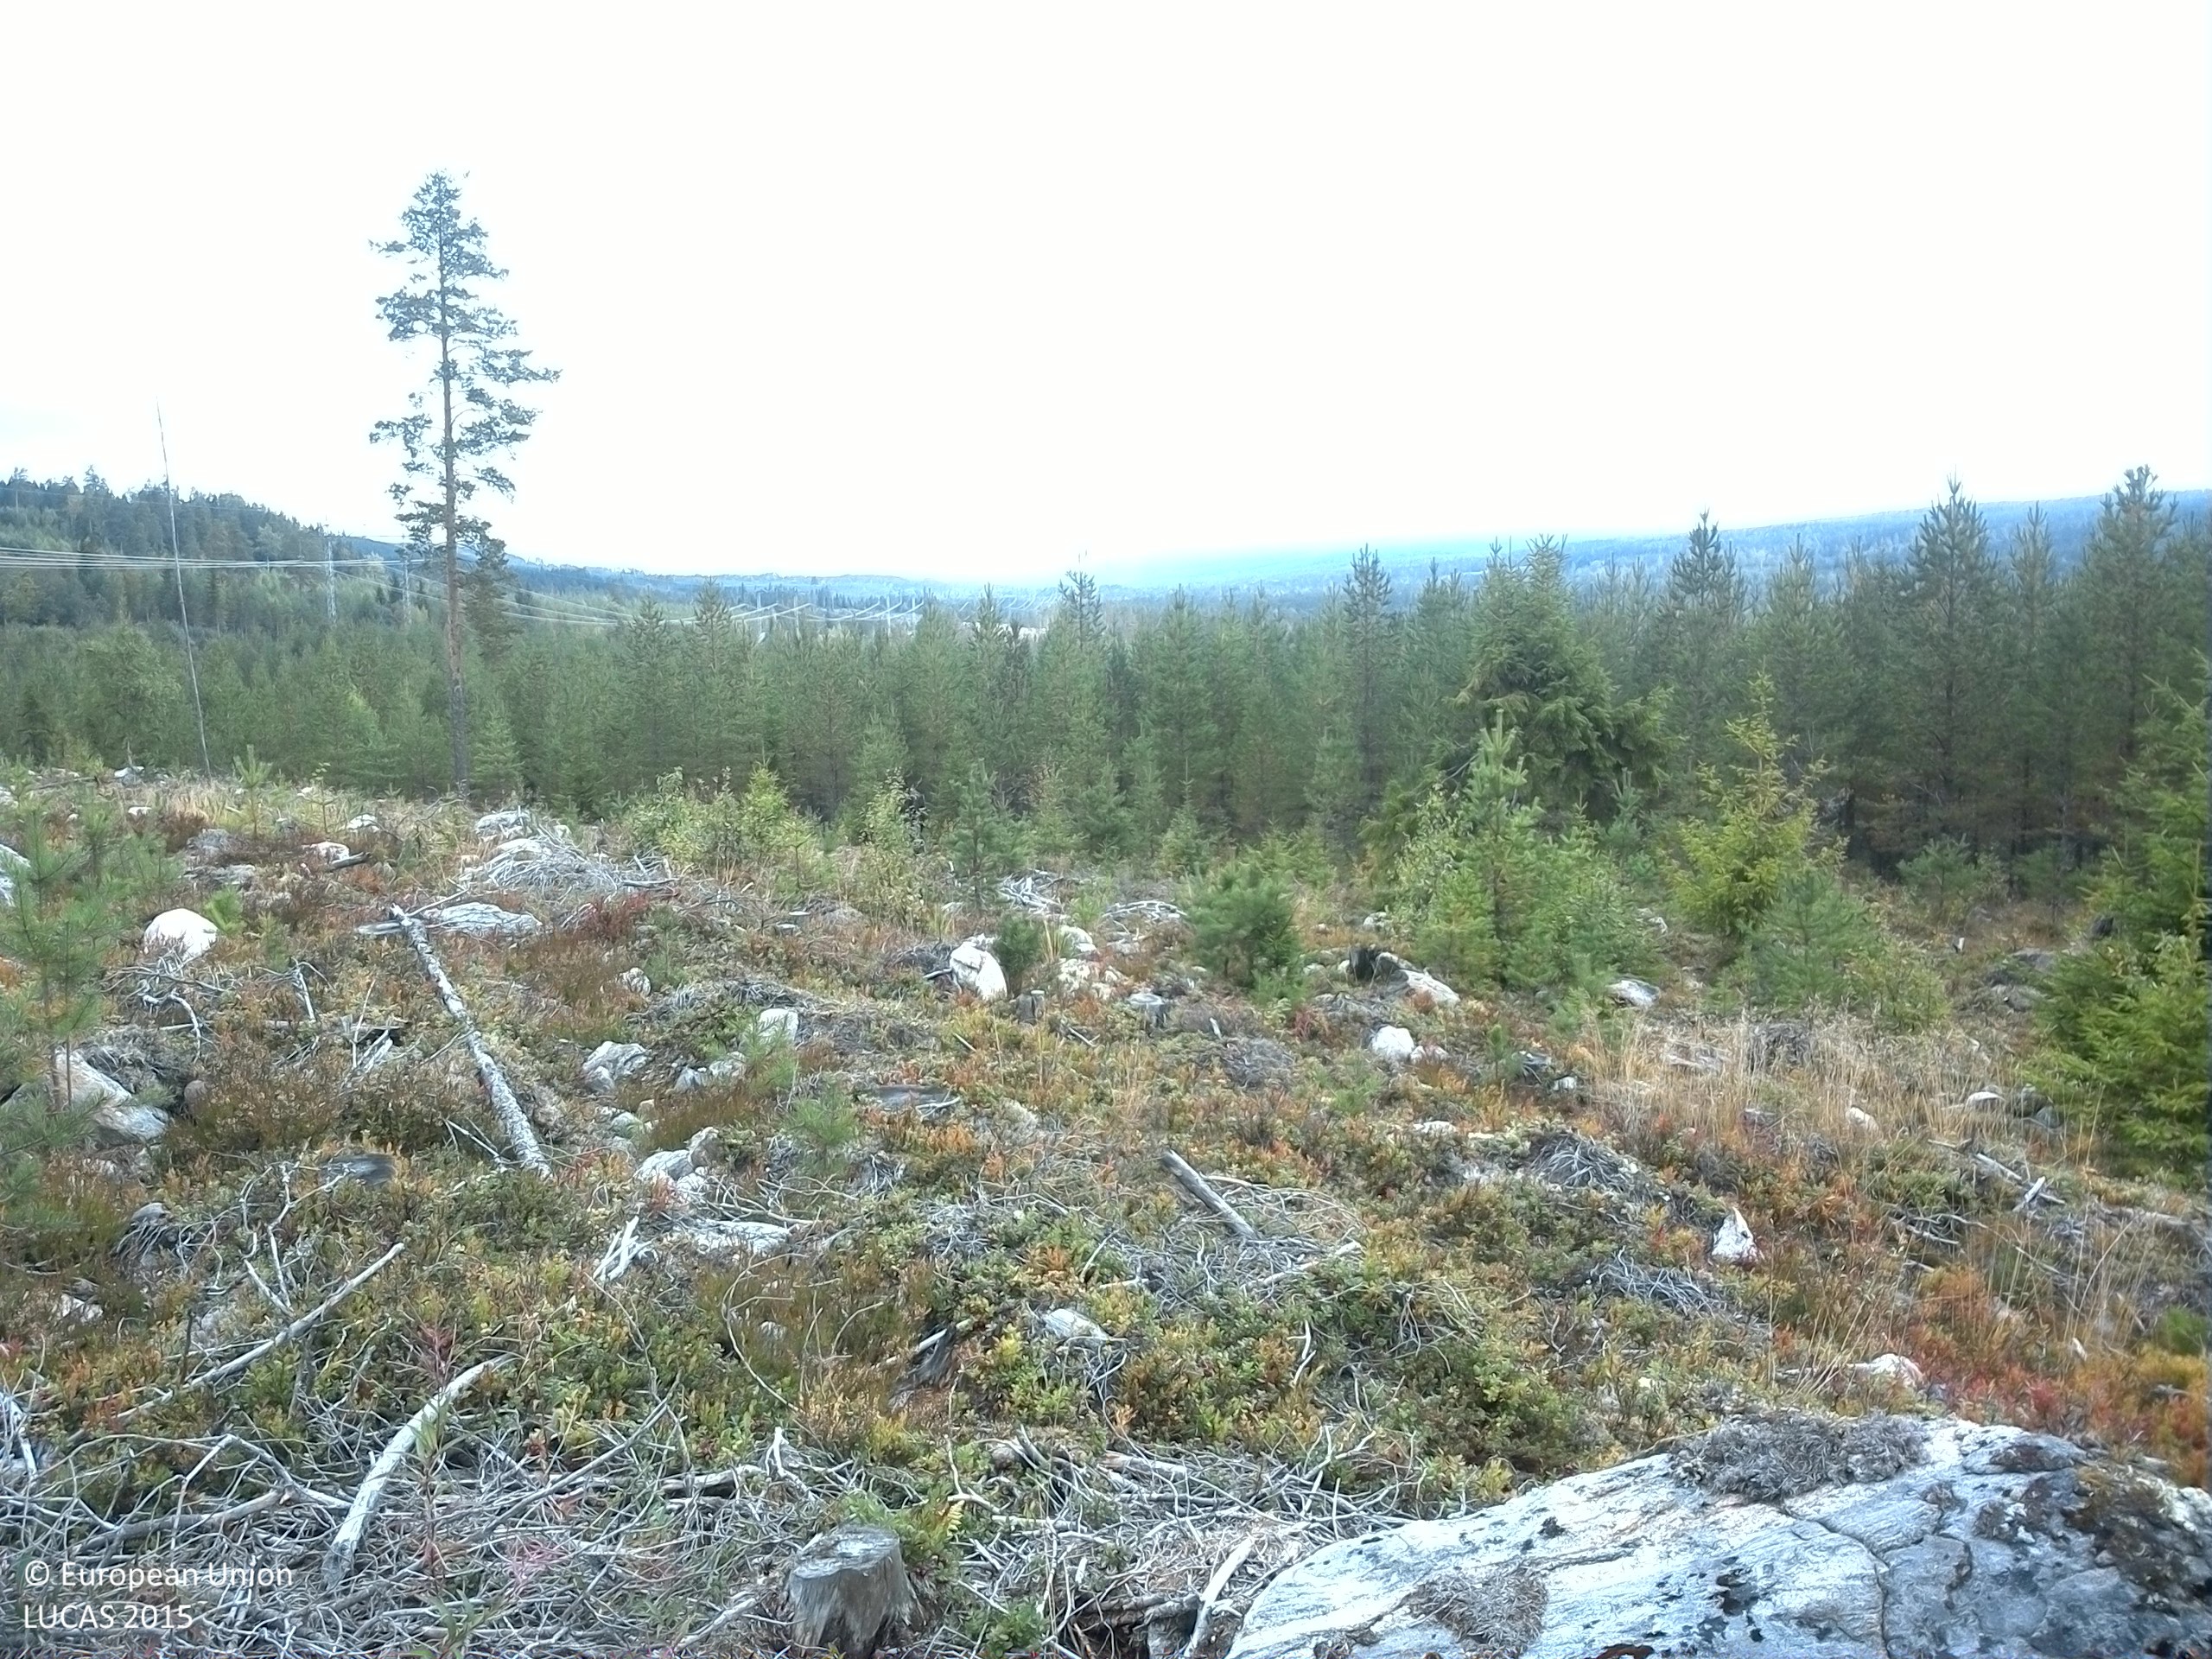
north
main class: Shrubland
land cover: Shrubland with sparse tree cover
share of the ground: > 75 %
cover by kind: shrubs 60 %, consolidated bare surface 20 %, lichens and mosses 15 %, coniferous forest trees 5 %
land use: Forestry
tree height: < 5 m
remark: Clear cut
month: September
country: SE
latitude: 61.6675
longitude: 15.3665
